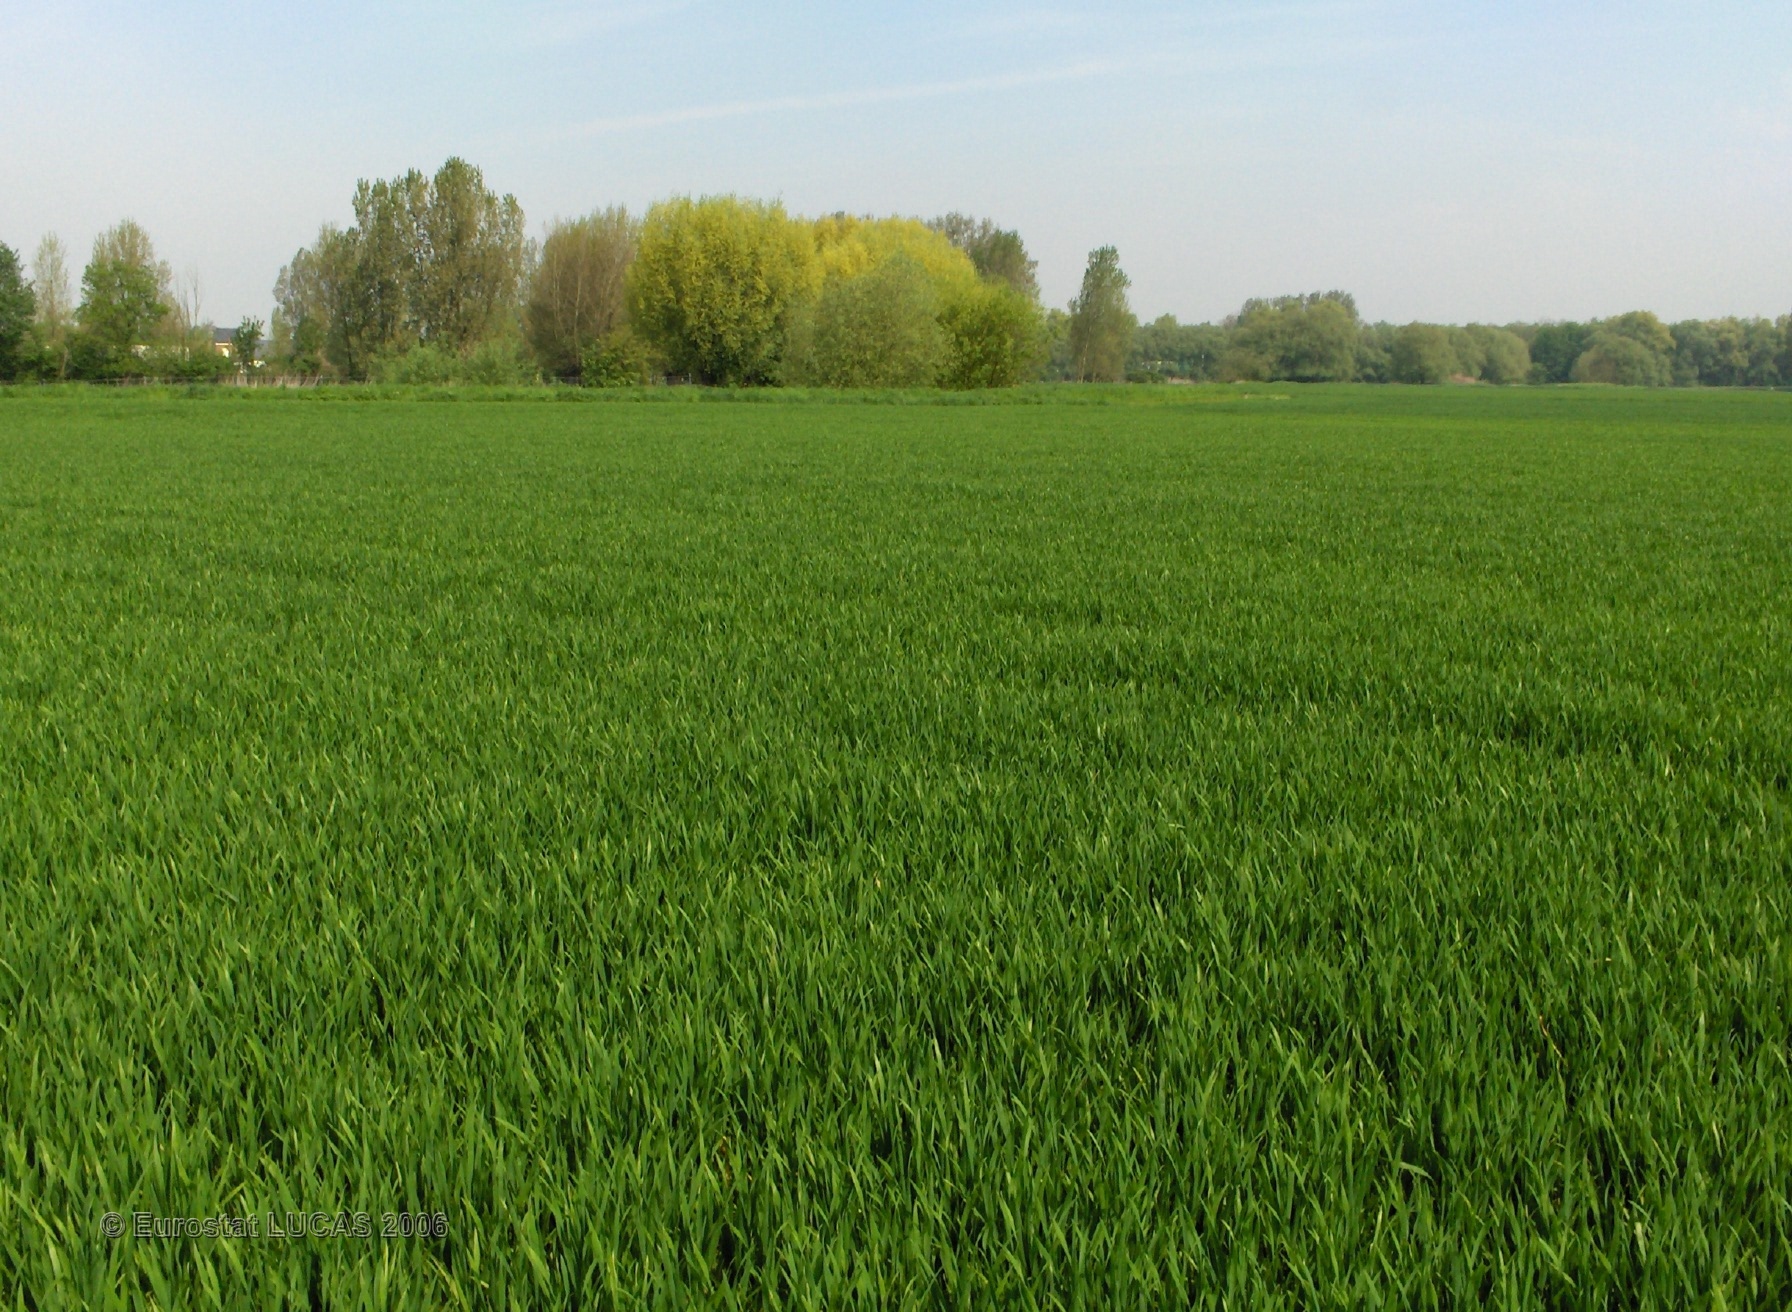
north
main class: Cropland
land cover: Common wheat
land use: Agriculture (excluding fallow land and kitchen gardens)
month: May
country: BE
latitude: 50.9699
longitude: 4.4846
